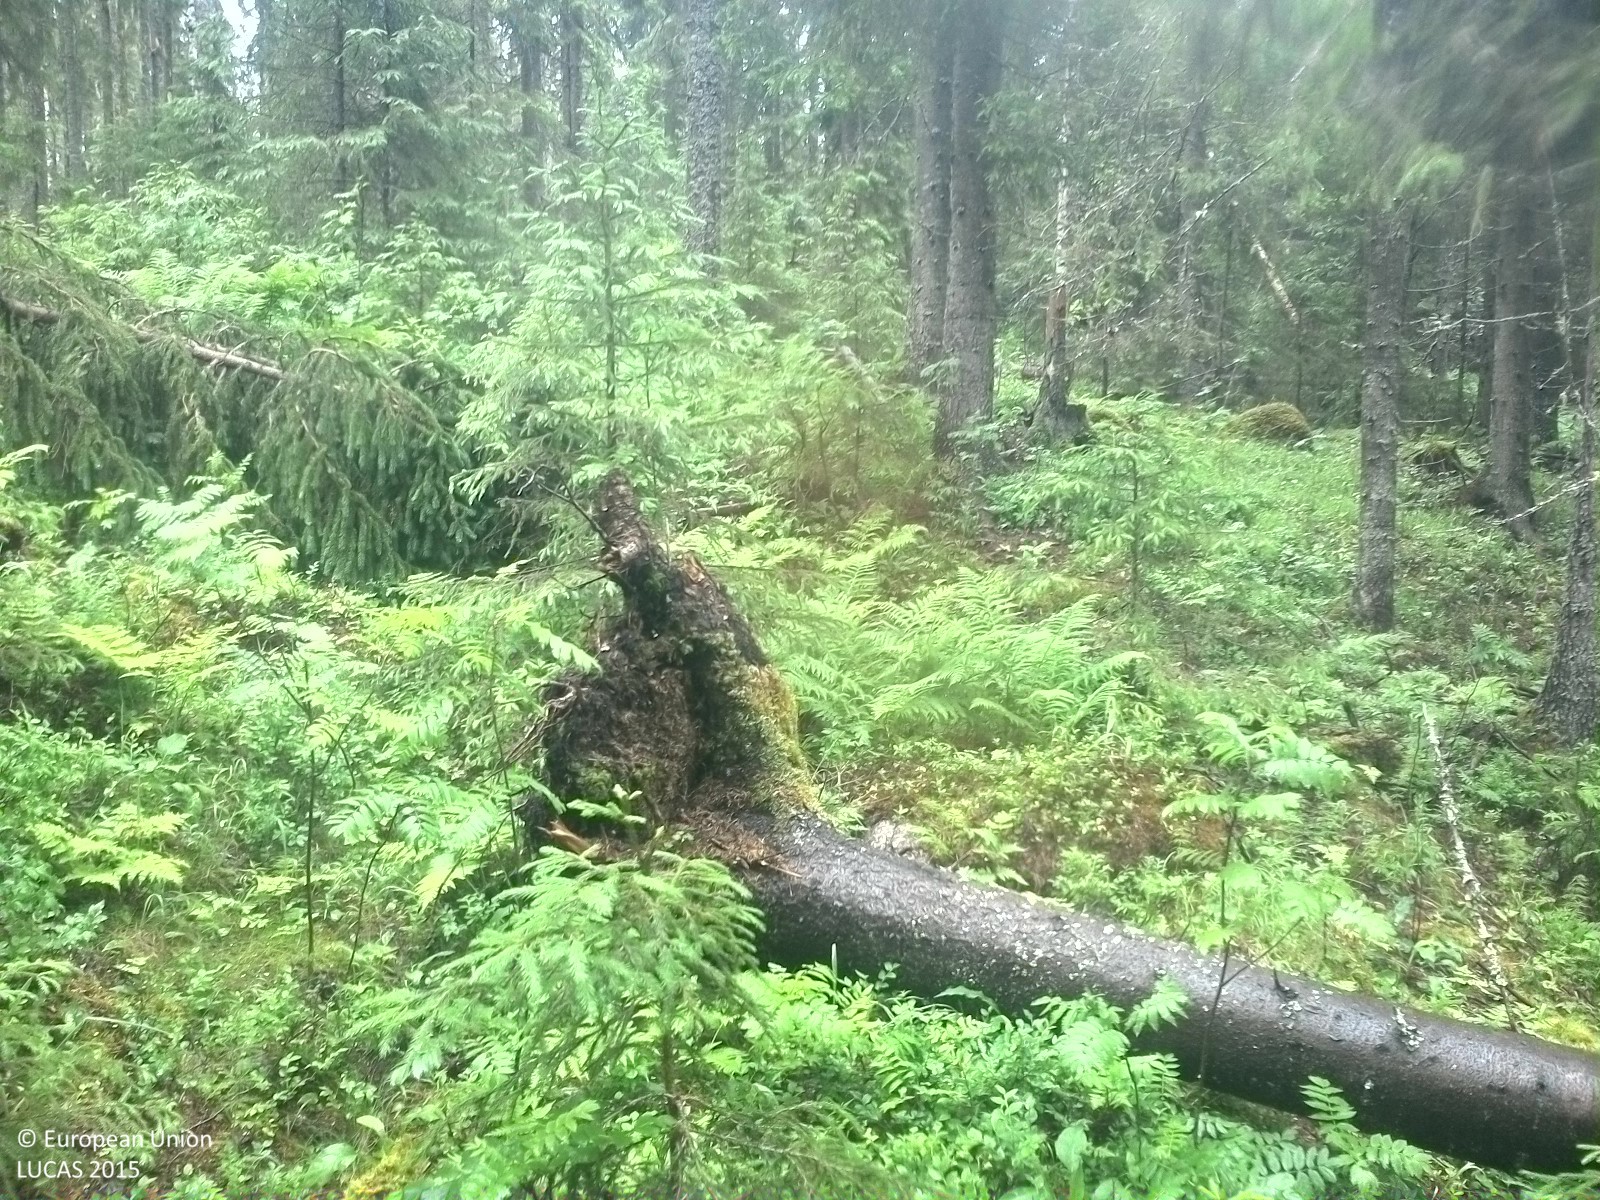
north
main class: Woodland
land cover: Spruce dominated mixed woodland
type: boreal forest
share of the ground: 50 - 75 %
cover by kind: coniferous forest trees 40 %, herbaceous plants 30 %, broadleaved forest trees 20 %, lichens and mosses 10 %
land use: Forestry
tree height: > 5 m
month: July
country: SE
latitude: 62.4756
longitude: 16.8265
